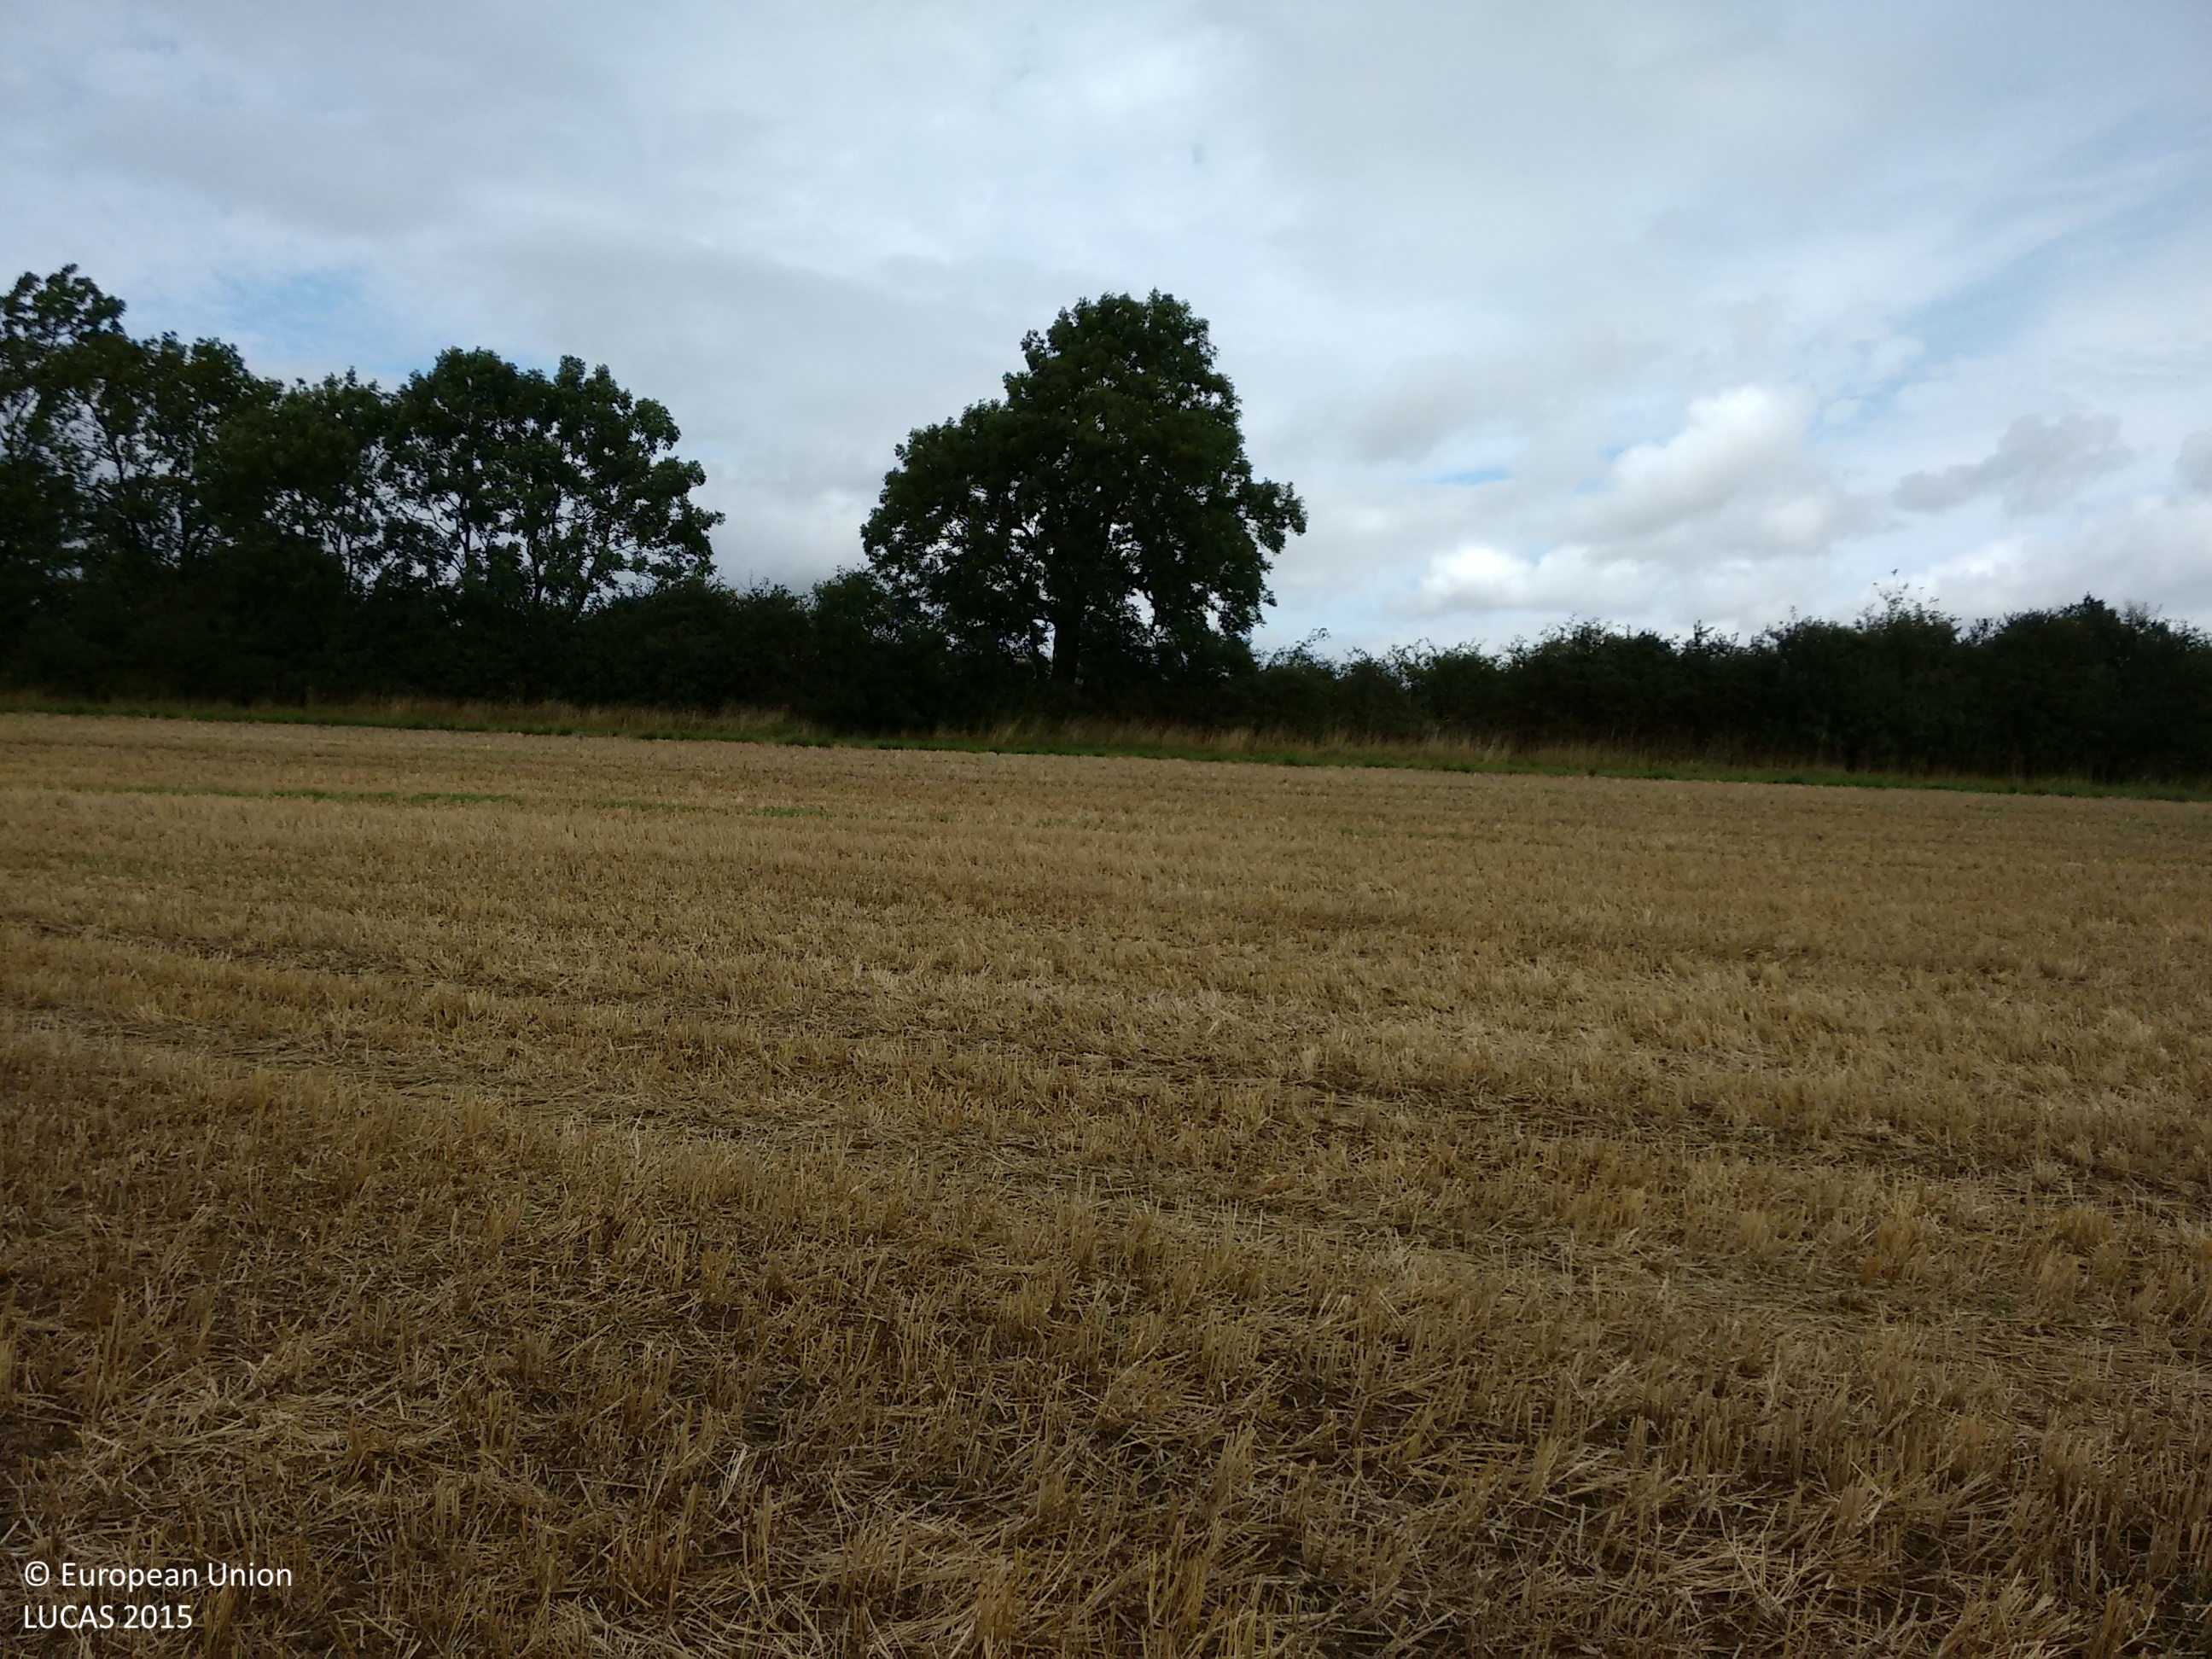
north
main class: Cropland
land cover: Common wheat
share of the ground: 10 - 25 %
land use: Agriculture (excluding fallow land and kitchen gardens)
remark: Harvested field
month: August
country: GB
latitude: 52.3670
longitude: -0.8665
